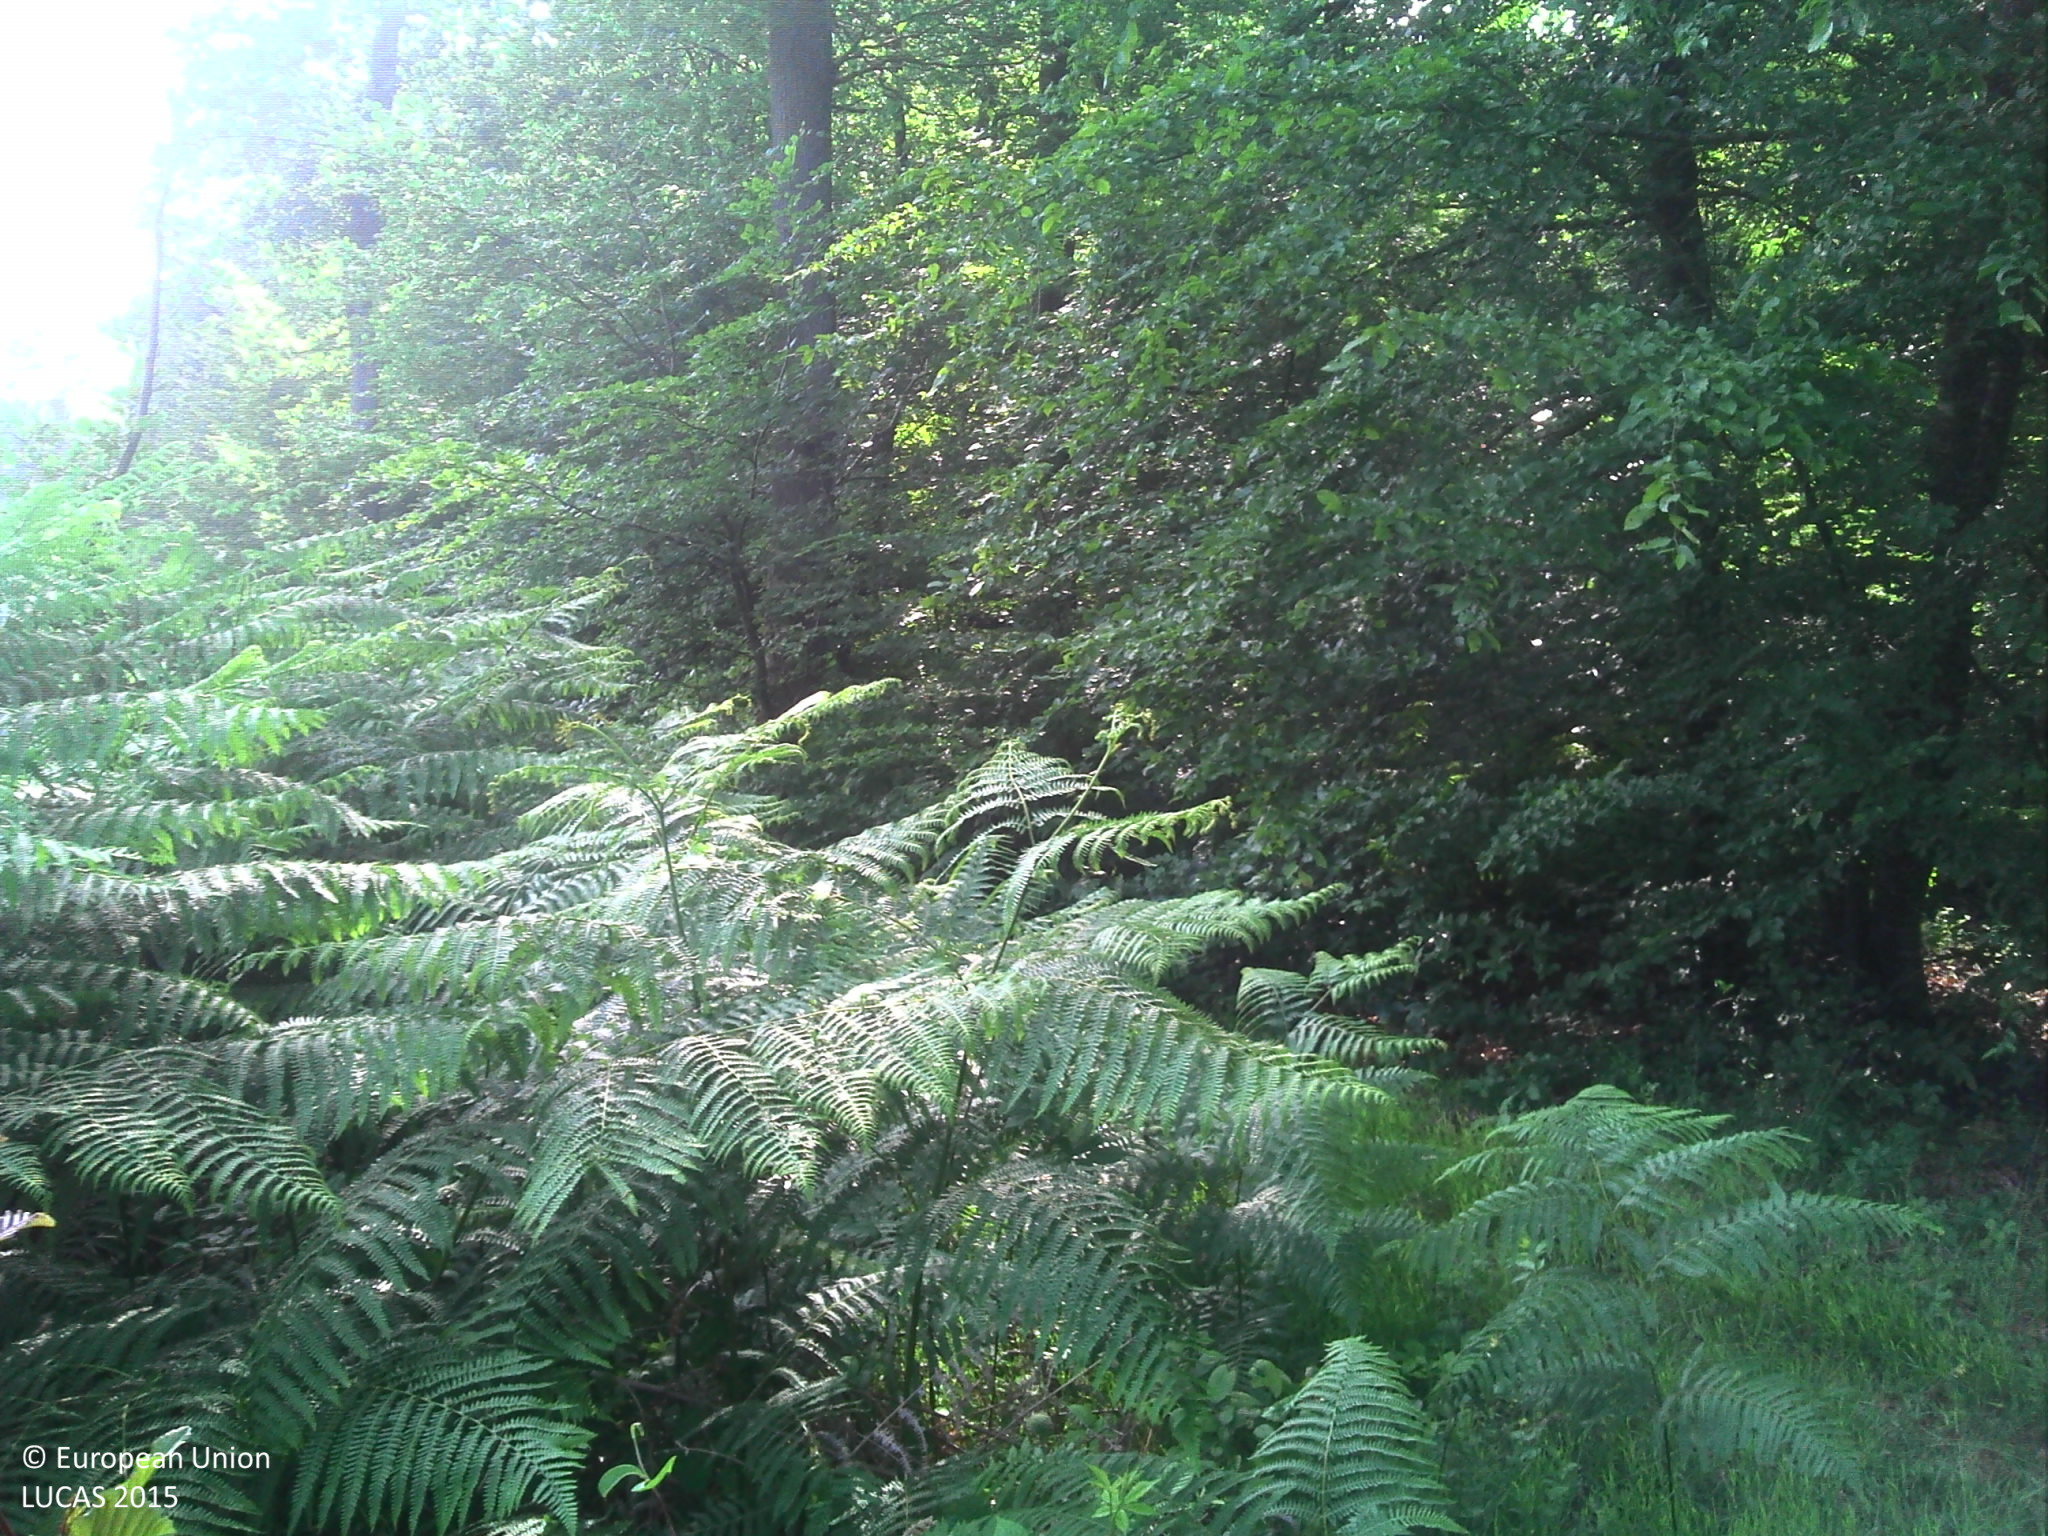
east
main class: Woodland
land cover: Broadleaved woodland
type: mesophytic deciduous forest
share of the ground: > 75 %
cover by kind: herbaceous plants 70 %, broadleaved forest trees 30 %
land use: Forestry
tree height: > 5 m
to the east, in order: Broadleaved woodland; Tracks; Broadleaved woodland; Tracks; Broadleaved woodland
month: June
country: FR
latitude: 47.5560
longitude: 1.3335
